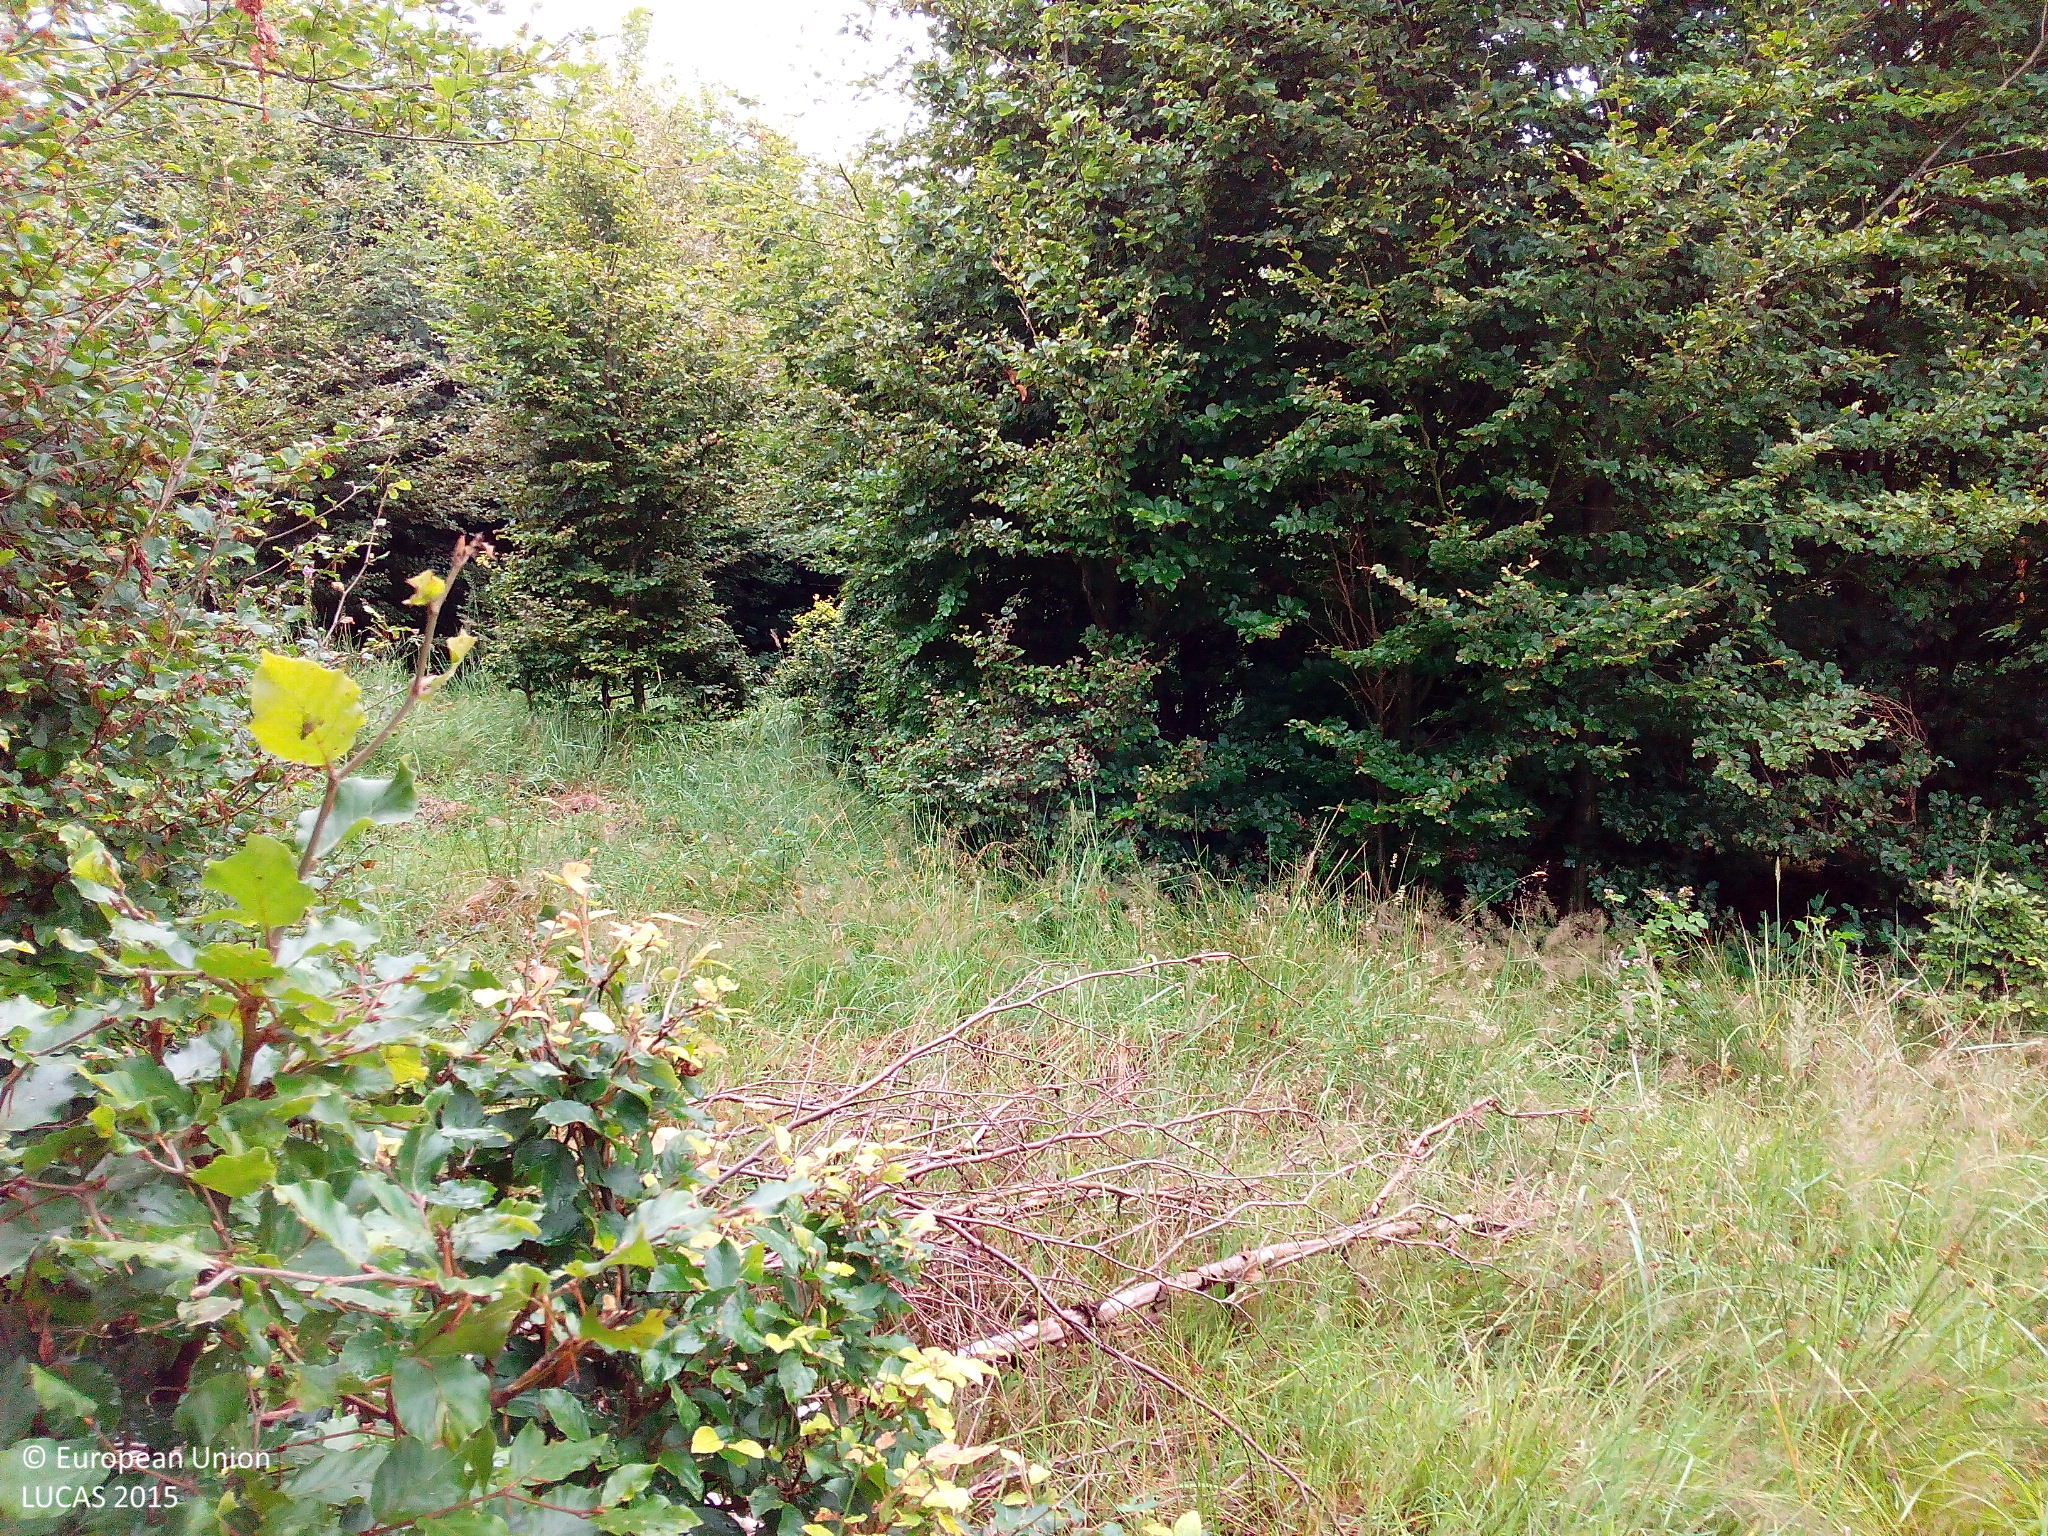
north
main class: Woodland
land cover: Broadleaved woodland
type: beech forest
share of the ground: > 75 %
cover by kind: broadleaved forest trees 95 %, herbaceous plants 5 %
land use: Forestry
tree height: > 5 m
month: July
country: DE
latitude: 50.9034
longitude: 9.9005
